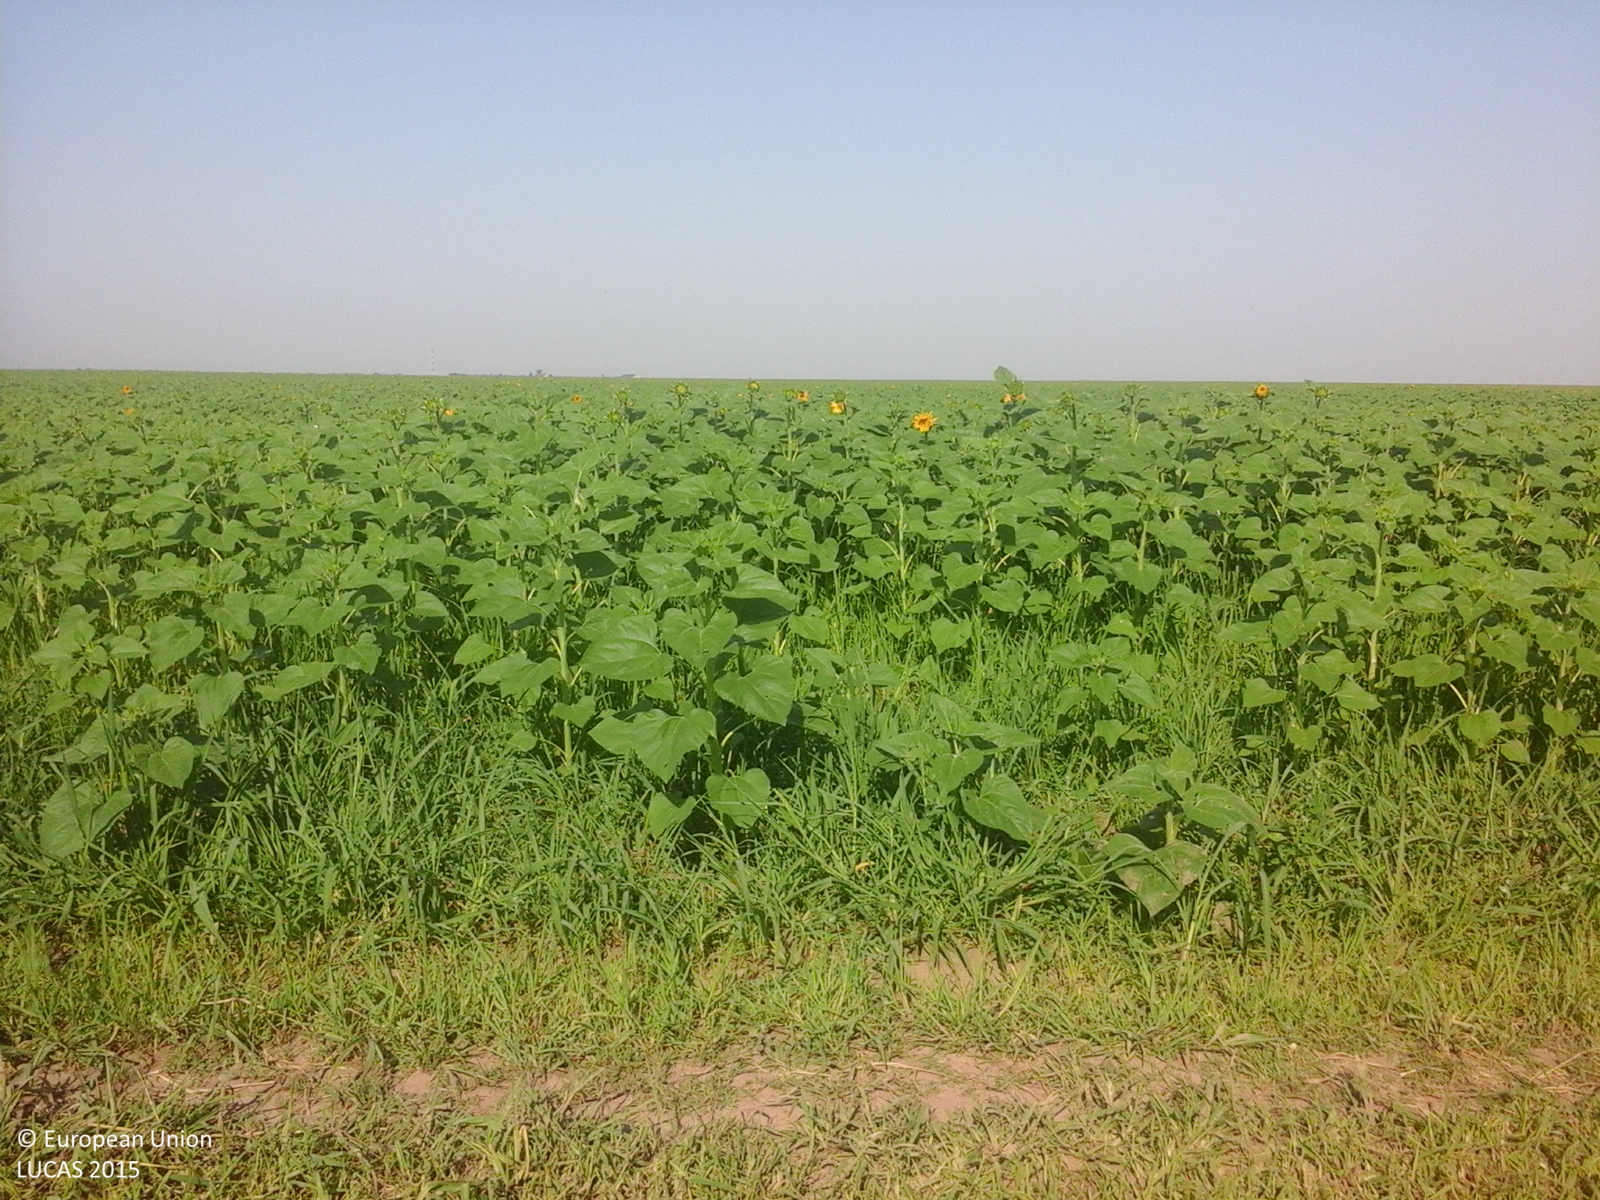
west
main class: Cropland
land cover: Sunflower
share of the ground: > 75 %
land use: Agriculture (excluding fallow land and kitchen gardens)
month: July
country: RO
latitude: 44.1322
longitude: 25.3712
